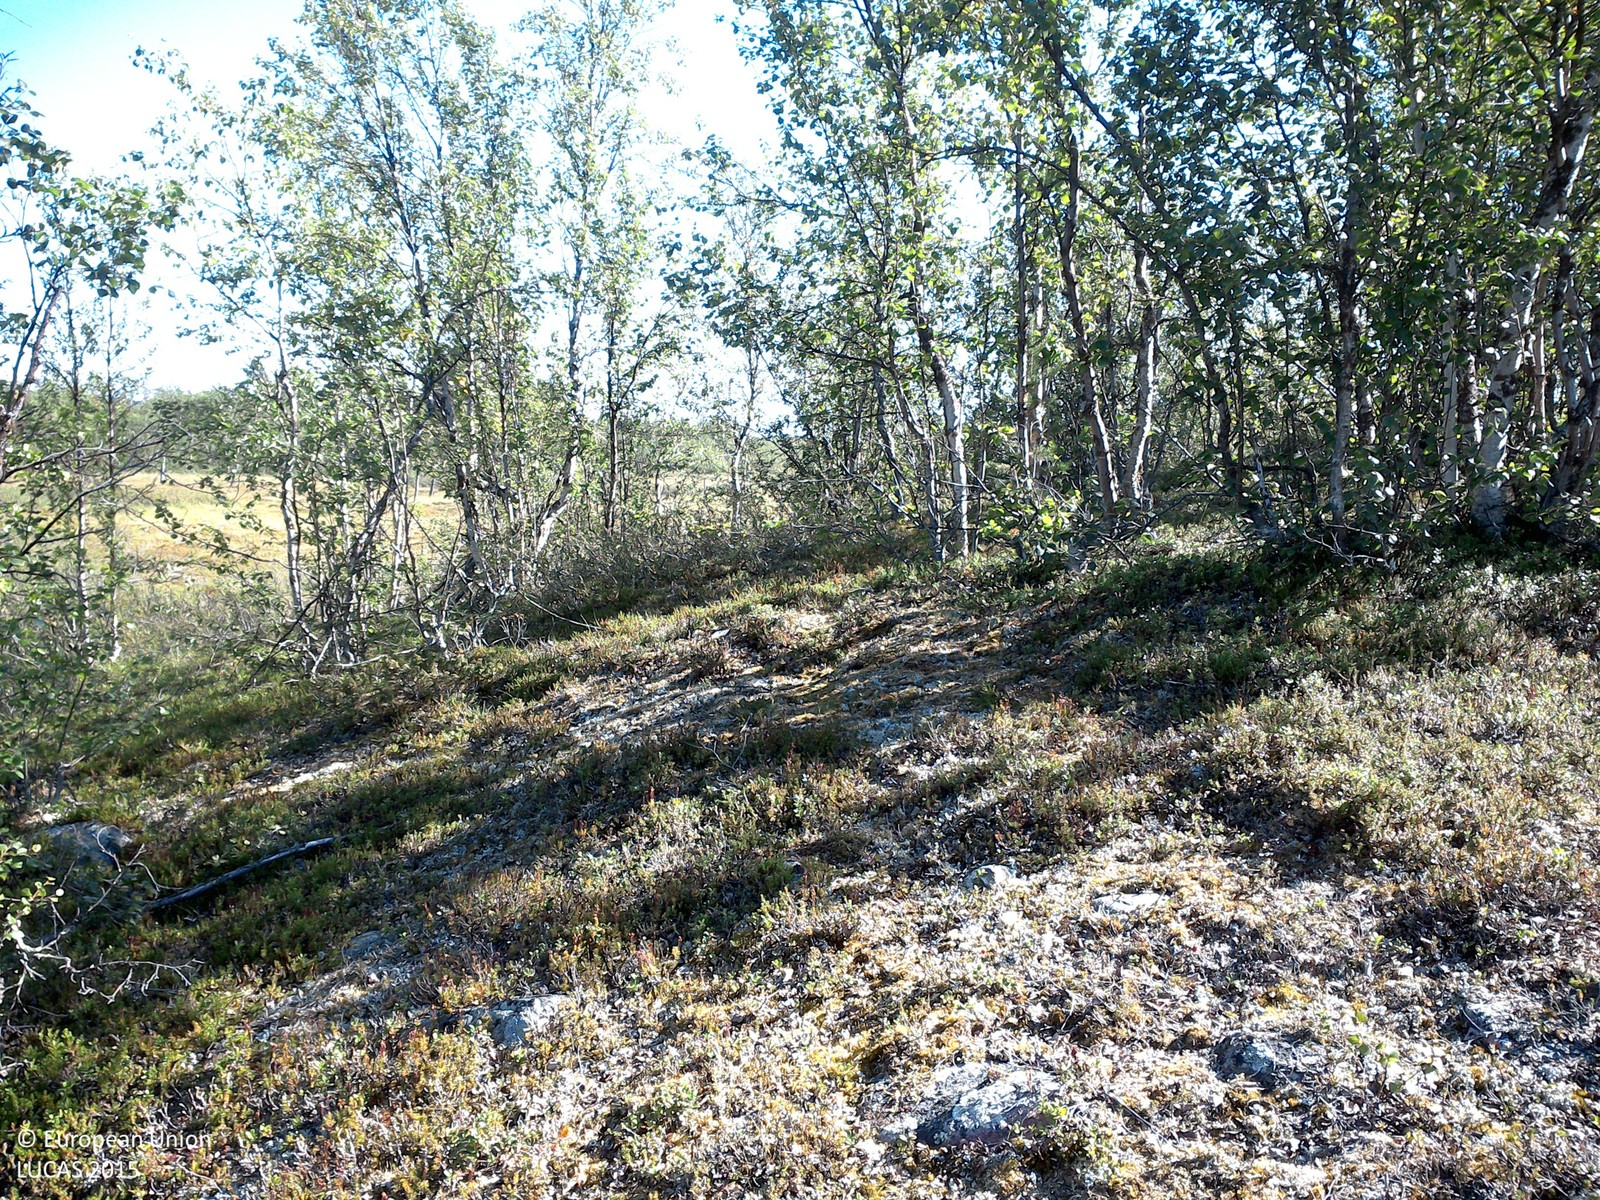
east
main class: Woodland
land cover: Broadleaved woodland
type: boreal forest
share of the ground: 10 - 25 %
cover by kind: shrubs 65 %, broadleaved forest trees 15 %, lichens and mosses 15 %, coniferous forest trees 5 %
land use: Amenities, museums, leisure
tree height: < 5 m
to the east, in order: Broadleaved woodland; Peatbogs; Shrubland with sparse tree cover; Peatbogs; Broadleaved woodland; Electric lines; Peatbogs; Inland fresh water bodies; Peatbogs
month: August
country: SE
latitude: 67.5457
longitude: 20.1013
